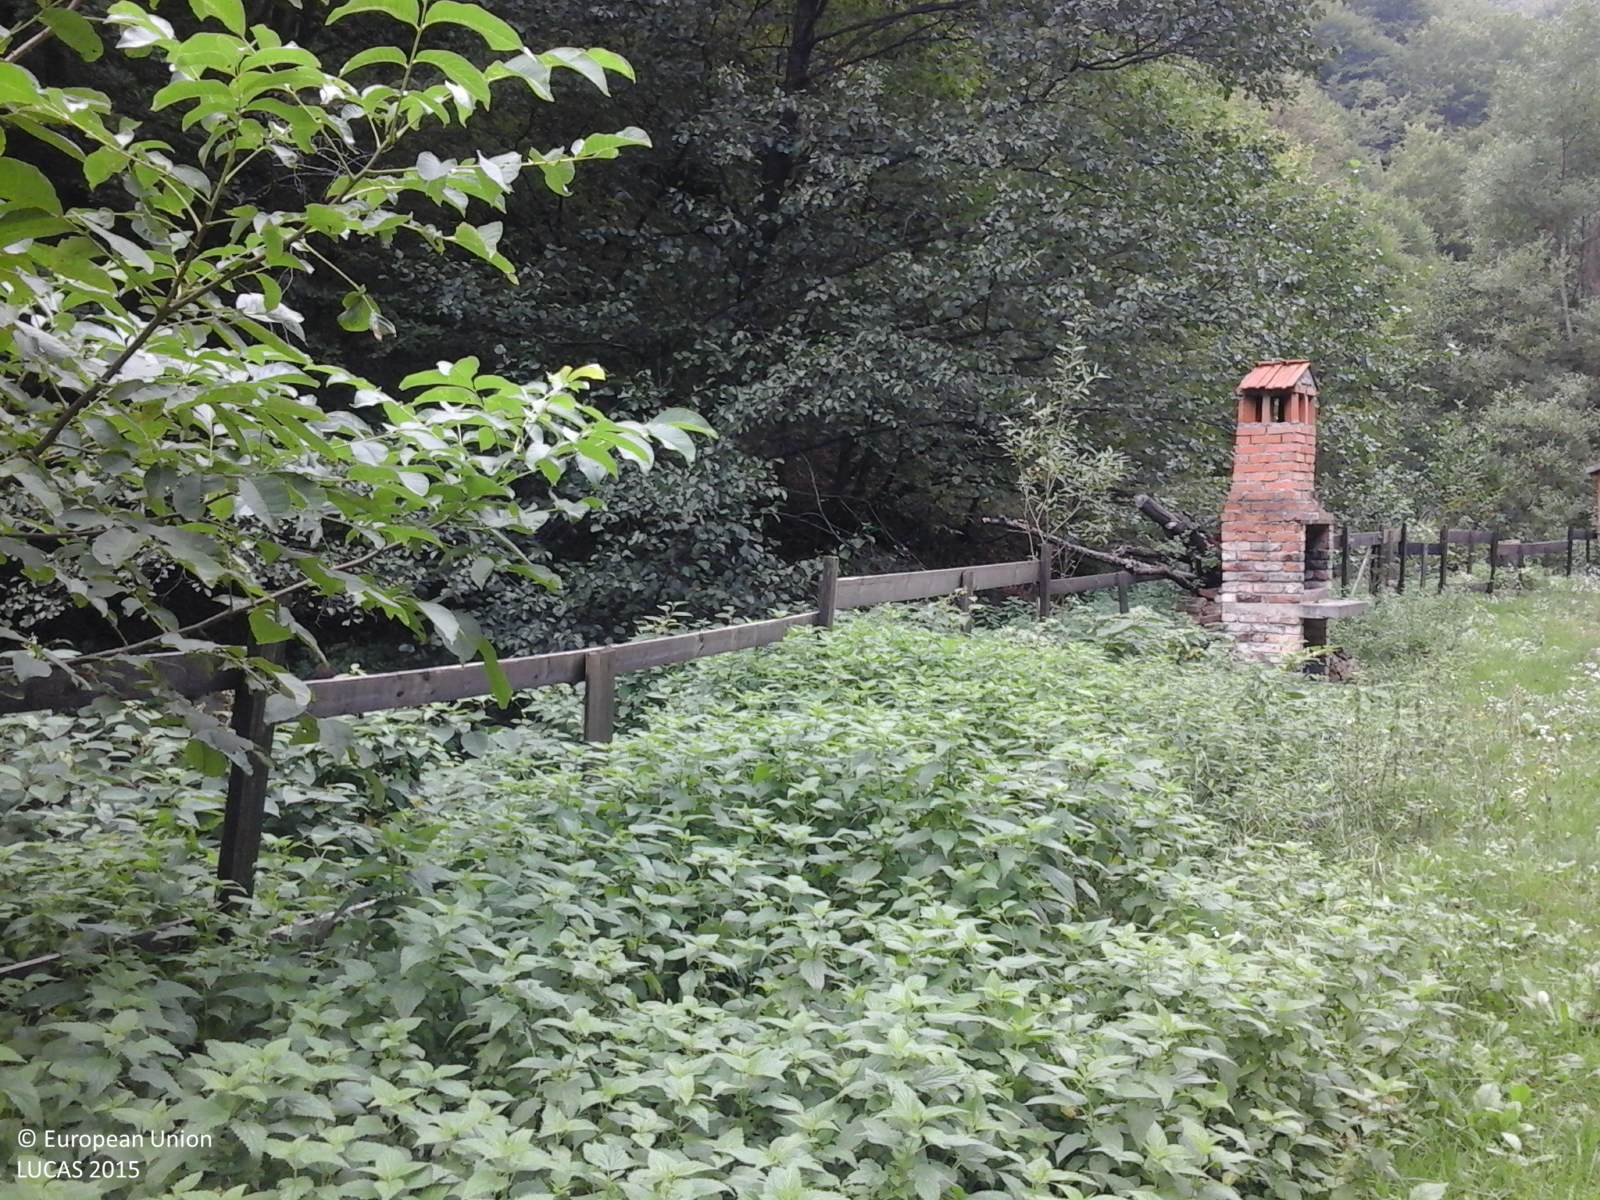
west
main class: Grassland
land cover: Grassland without tree/shrub cover
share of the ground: > 75 %
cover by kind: herbaceous plants 100 %
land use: Residential
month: September
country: RO
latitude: 45.7439
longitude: 22.7888
